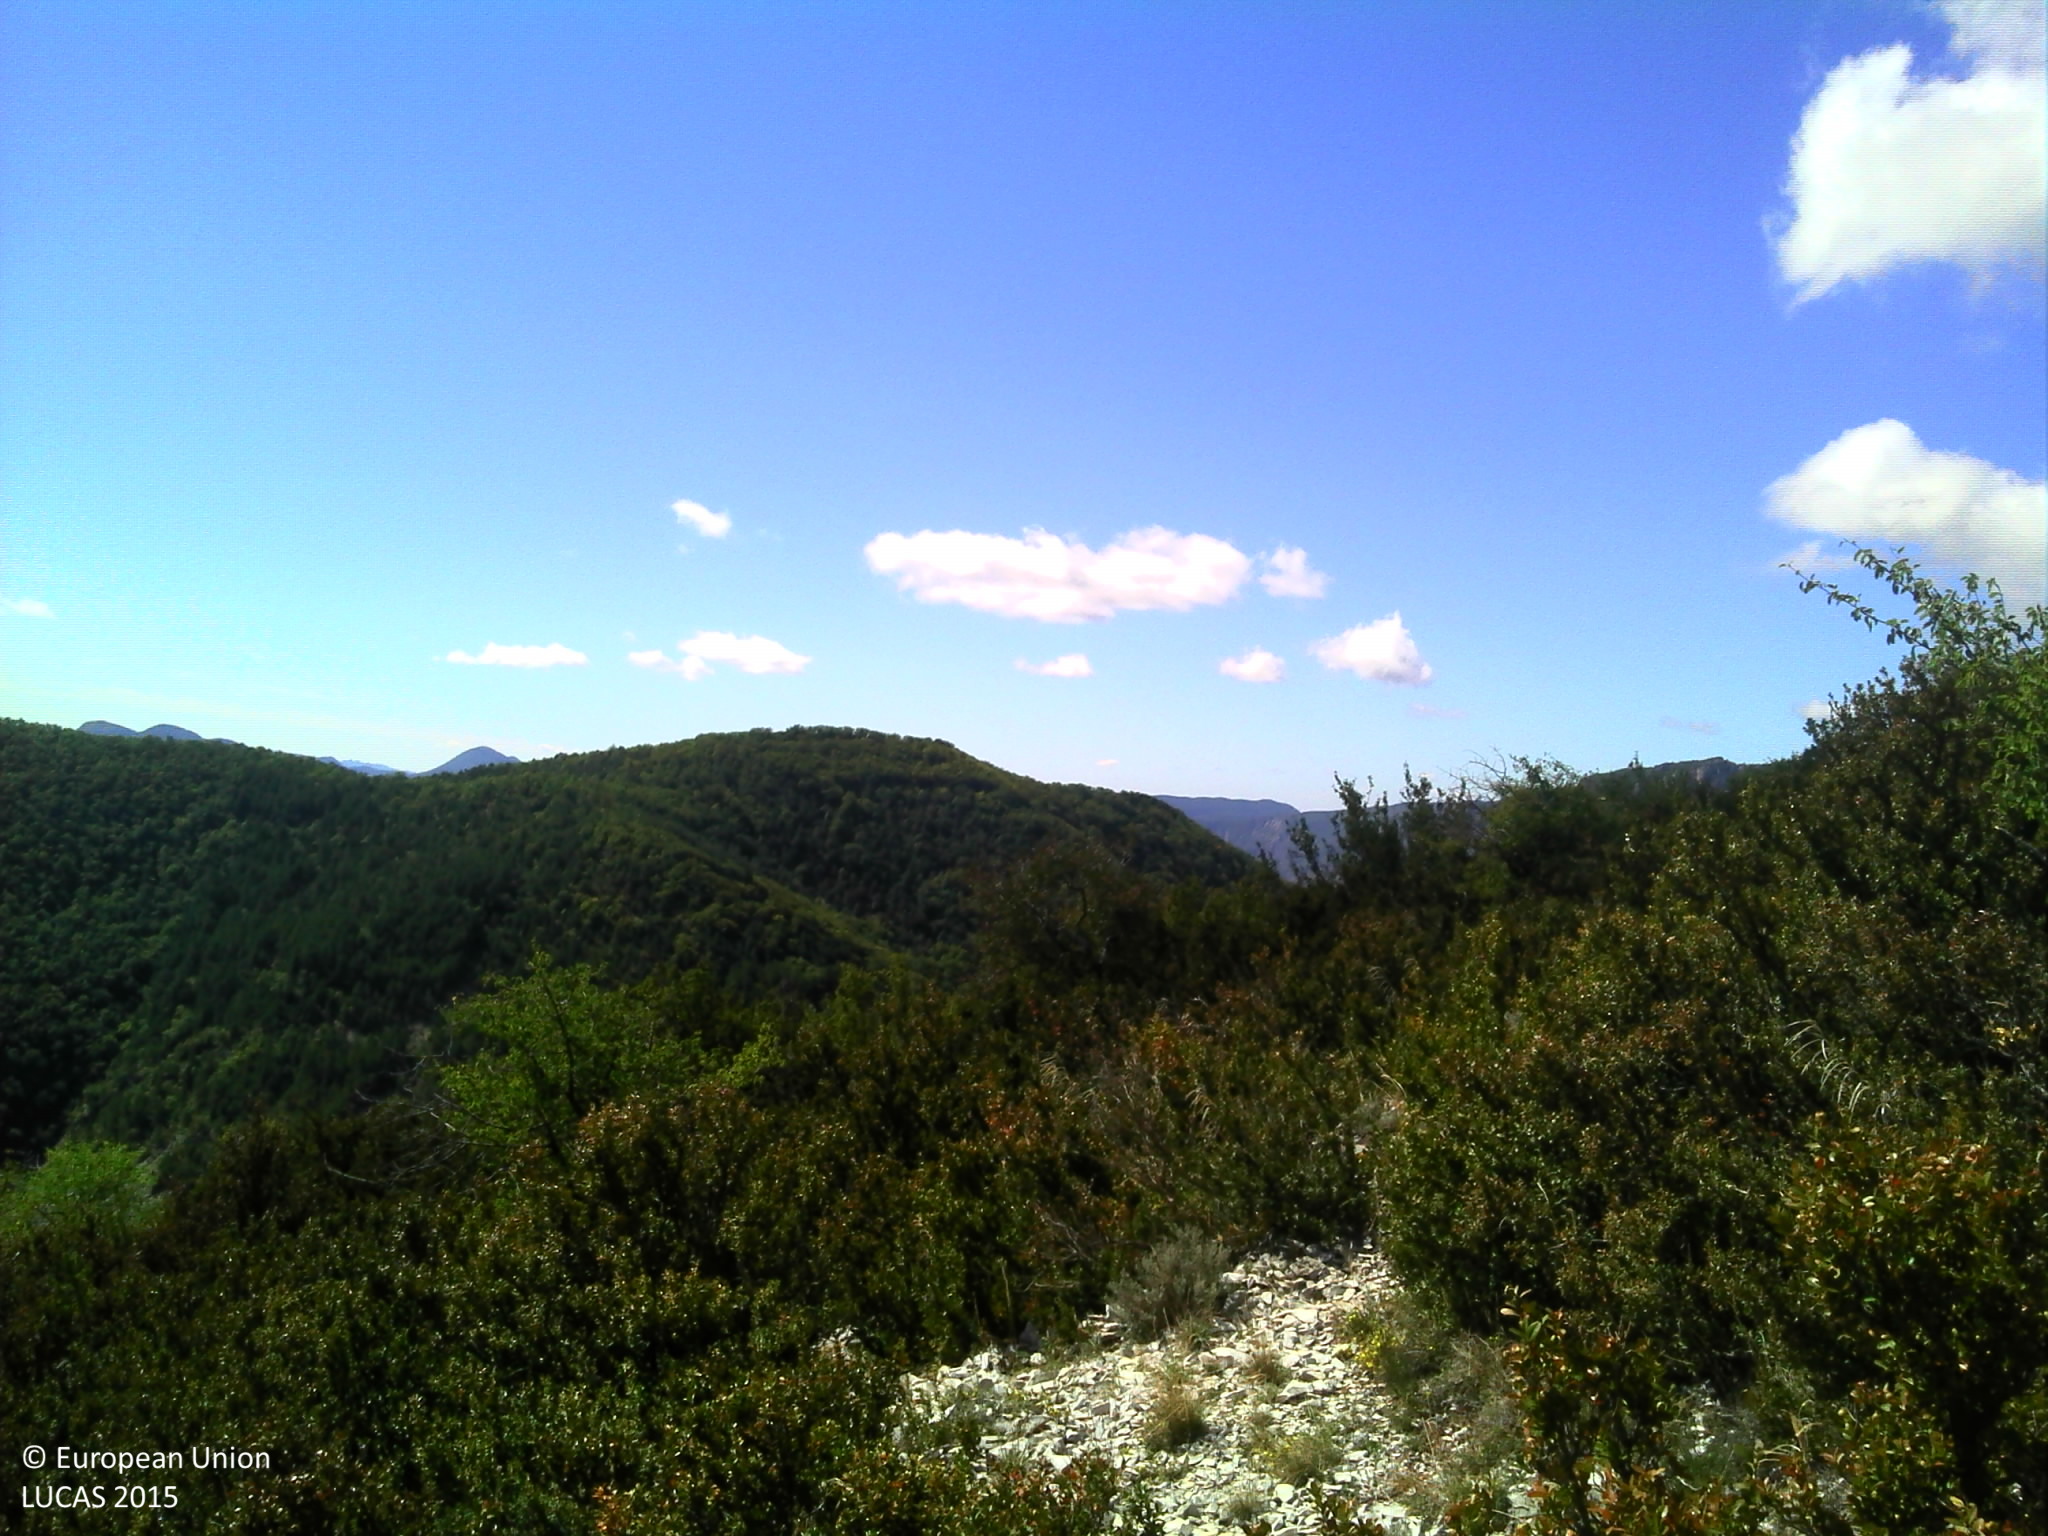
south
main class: Shrubland
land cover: Shrubland without tree cover
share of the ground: > 75 %
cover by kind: shrubs 90 %, unconsolidated bare surface 10 %
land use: Semi-natural and natural areas not in use
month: September
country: FR
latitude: 44.4594
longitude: 5.2689
